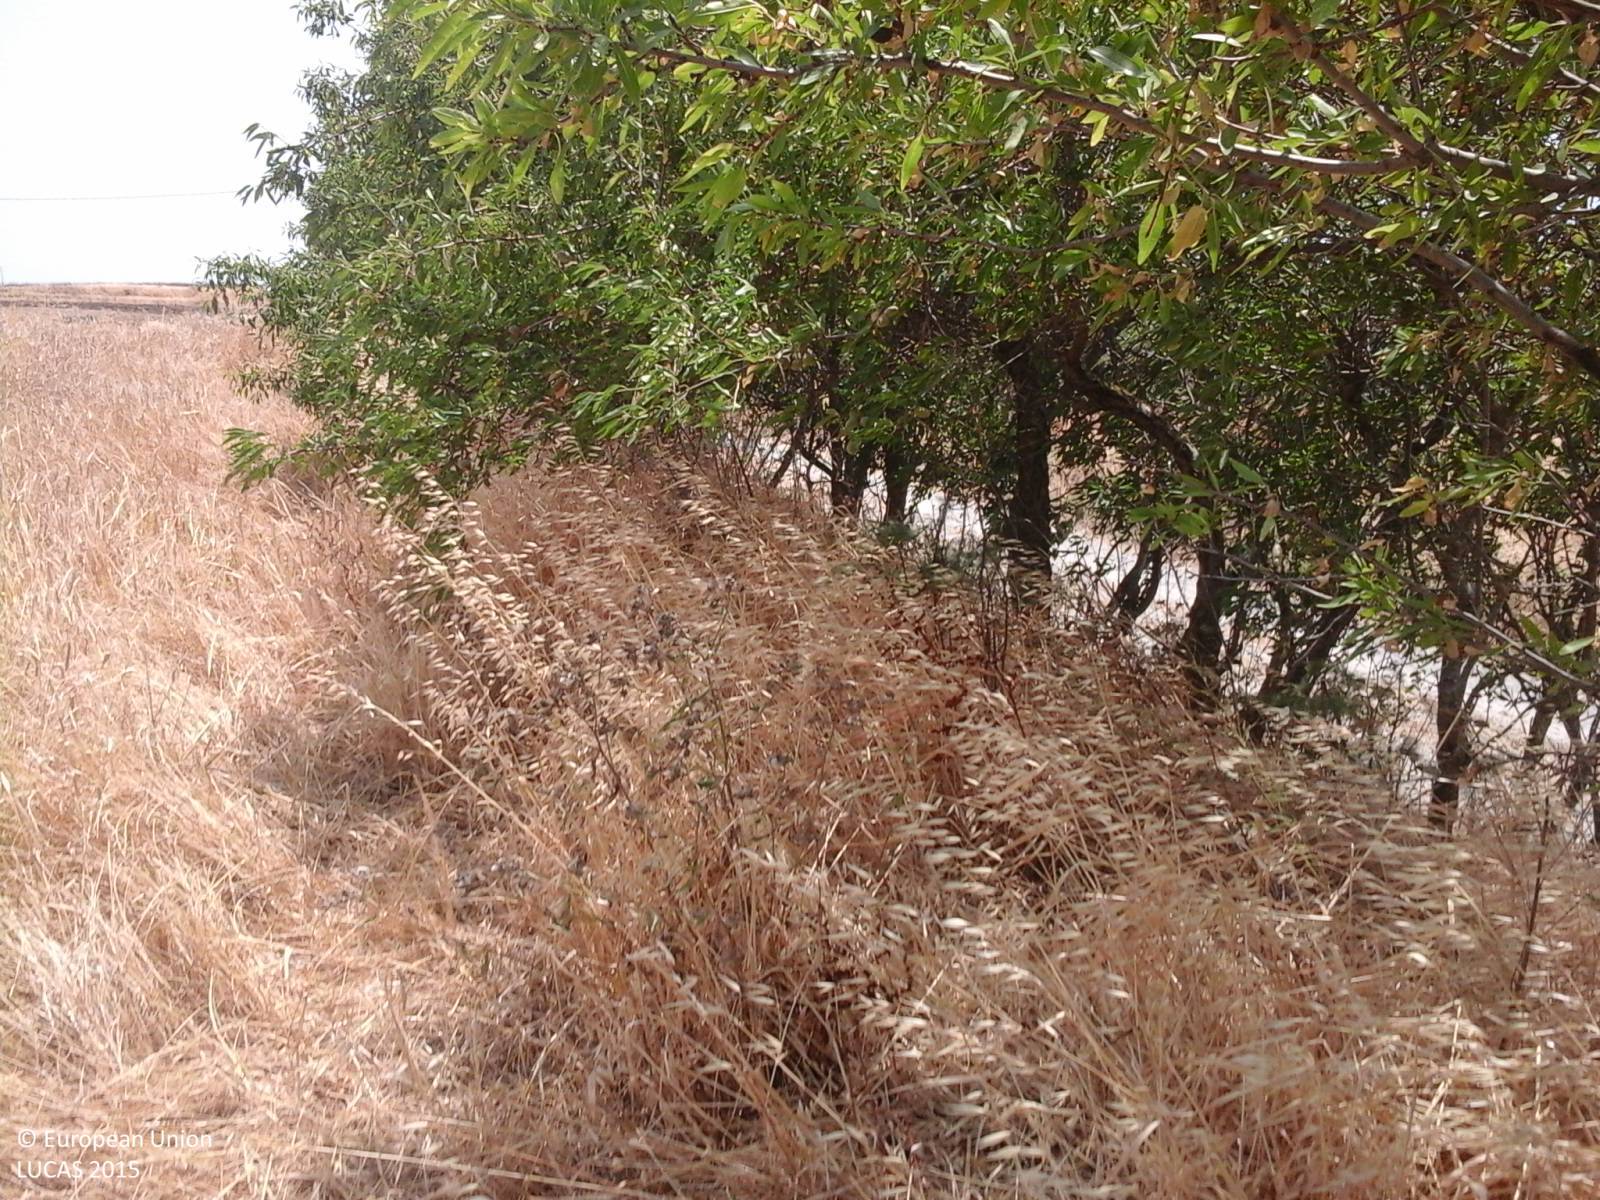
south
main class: Cropland
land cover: Barley
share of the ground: > 75 %
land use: Agriculture (excluding fallow land and kitchen gardens)
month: July
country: IT
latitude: 39.6084
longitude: 8.8305
